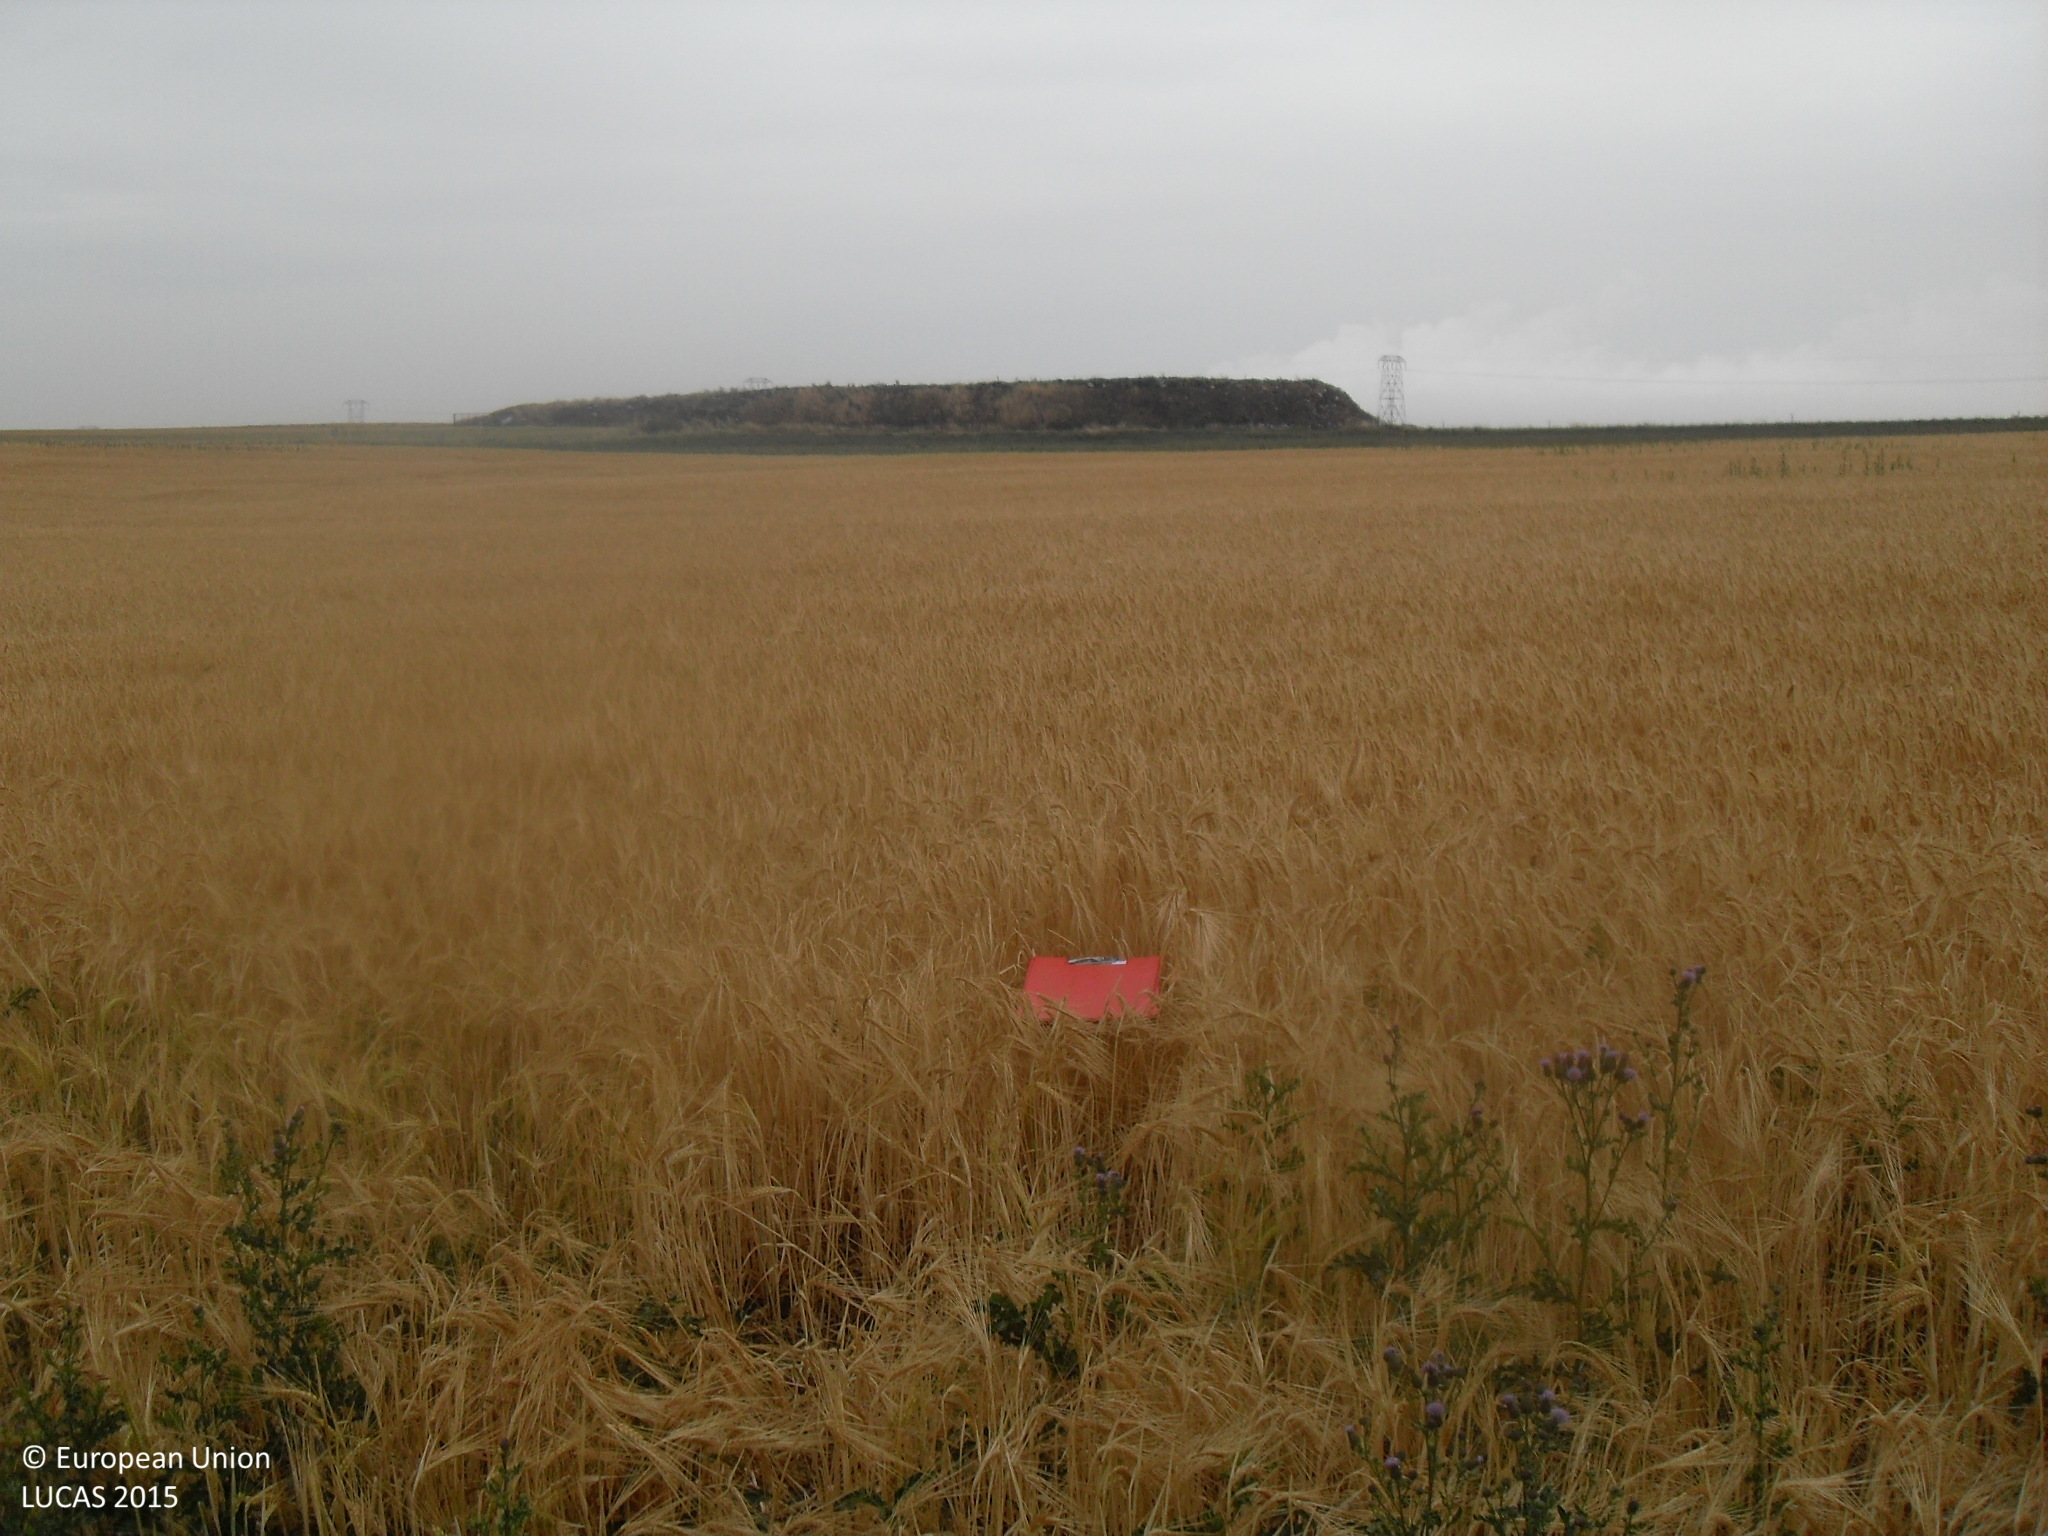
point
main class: Cropland
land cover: Barley
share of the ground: > 75 %
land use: Agriculture (excluding fallow land and kitchen gardens)
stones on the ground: < 10 %
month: June
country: ES
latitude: 41.1061
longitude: -5.7149
